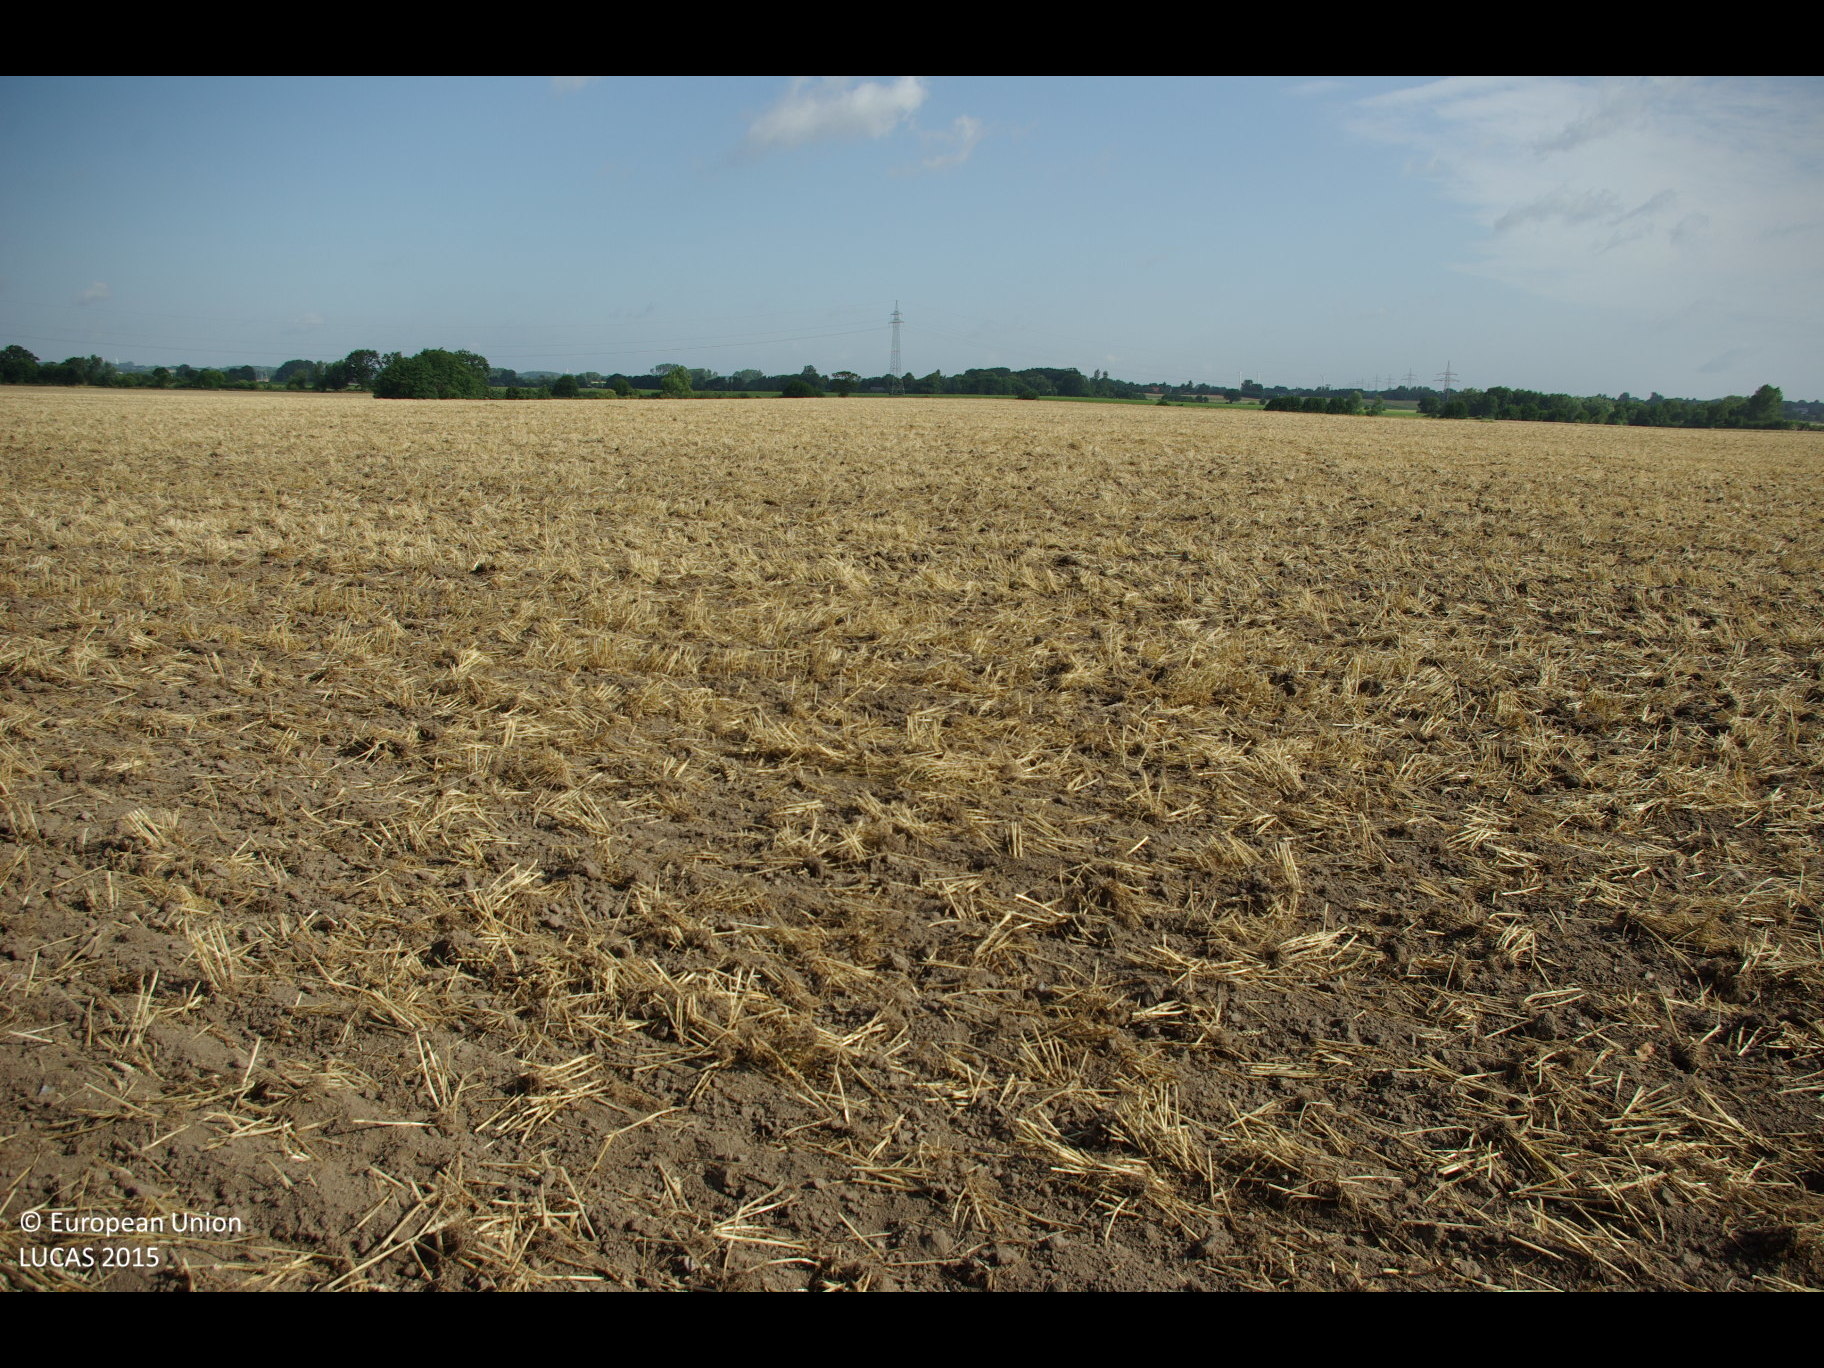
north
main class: Cropland
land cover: Common wheat
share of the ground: < 10 %
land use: Agriculture (excluding fallow land and kitchen gardens)
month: July
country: DE
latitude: 54.6060
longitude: 9.9536
